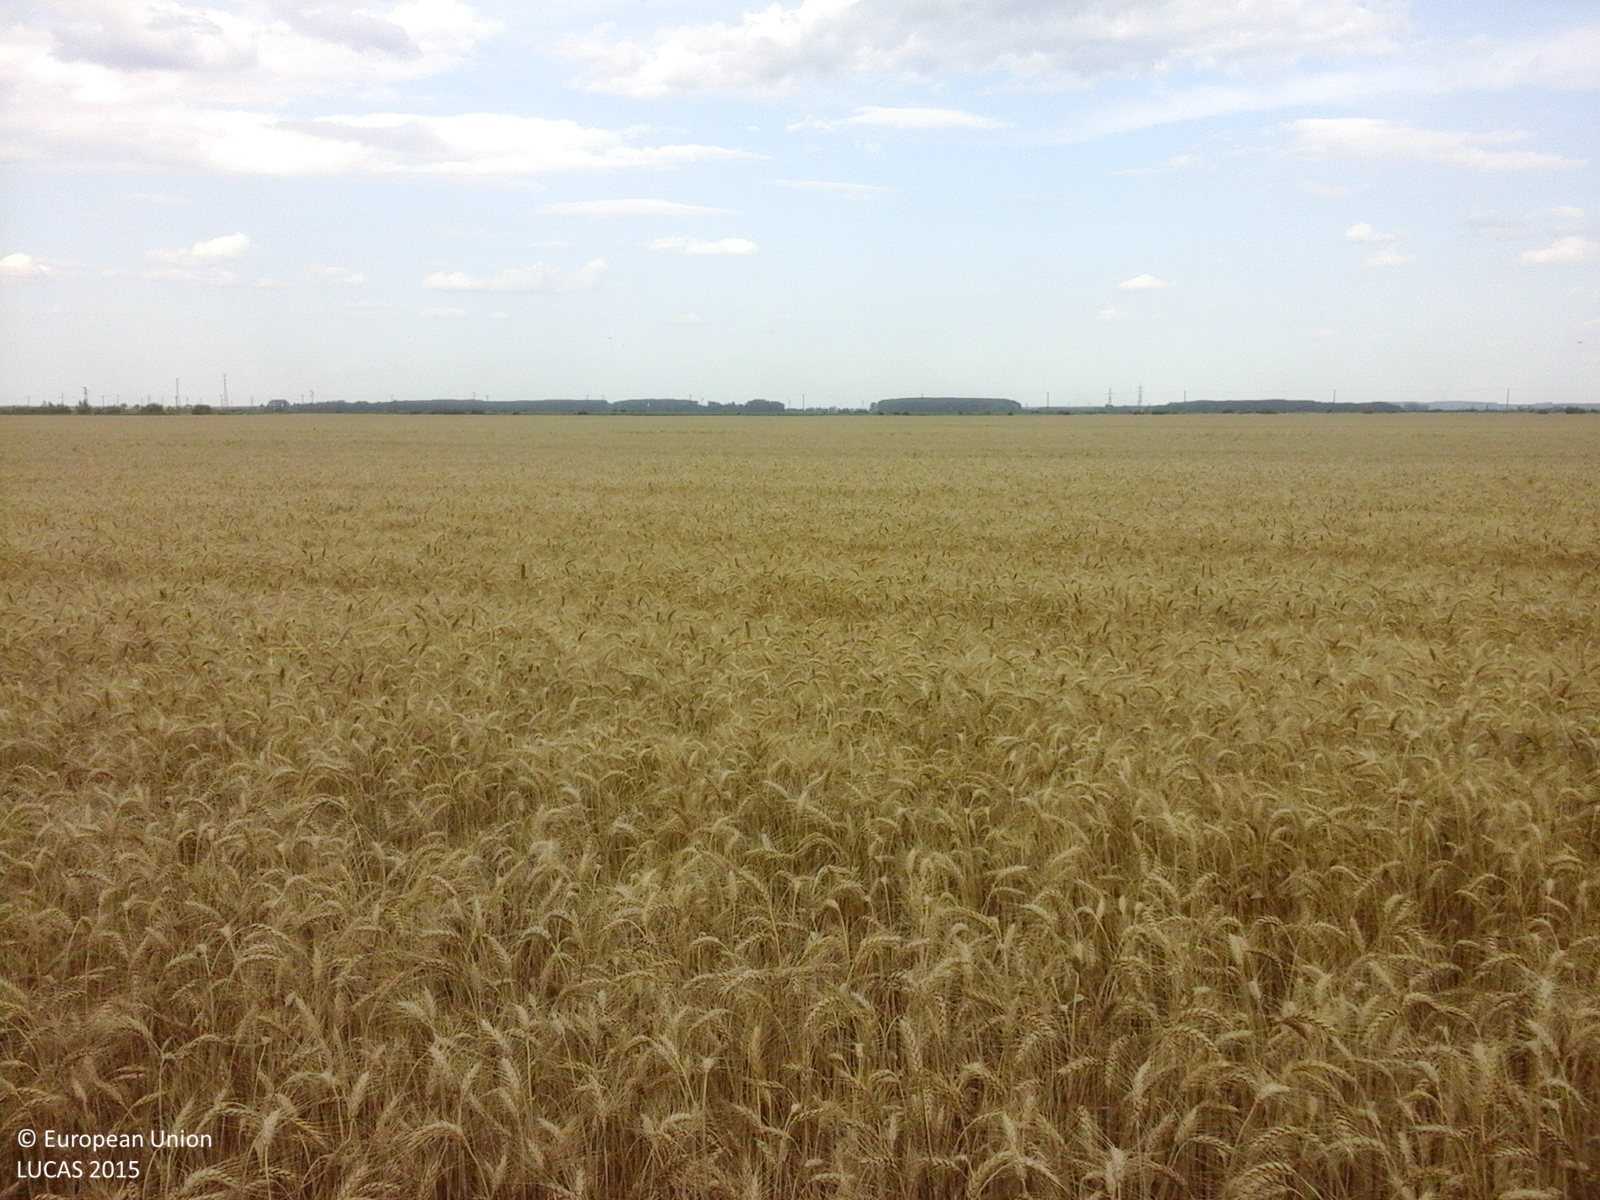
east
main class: Cropland
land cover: Common wheat
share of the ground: > 75 %
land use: Agriculture (excluding fallow land and kitchen gardens)
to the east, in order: Common wheat
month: June
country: RO
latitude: 44.1240
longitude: 26.5976
